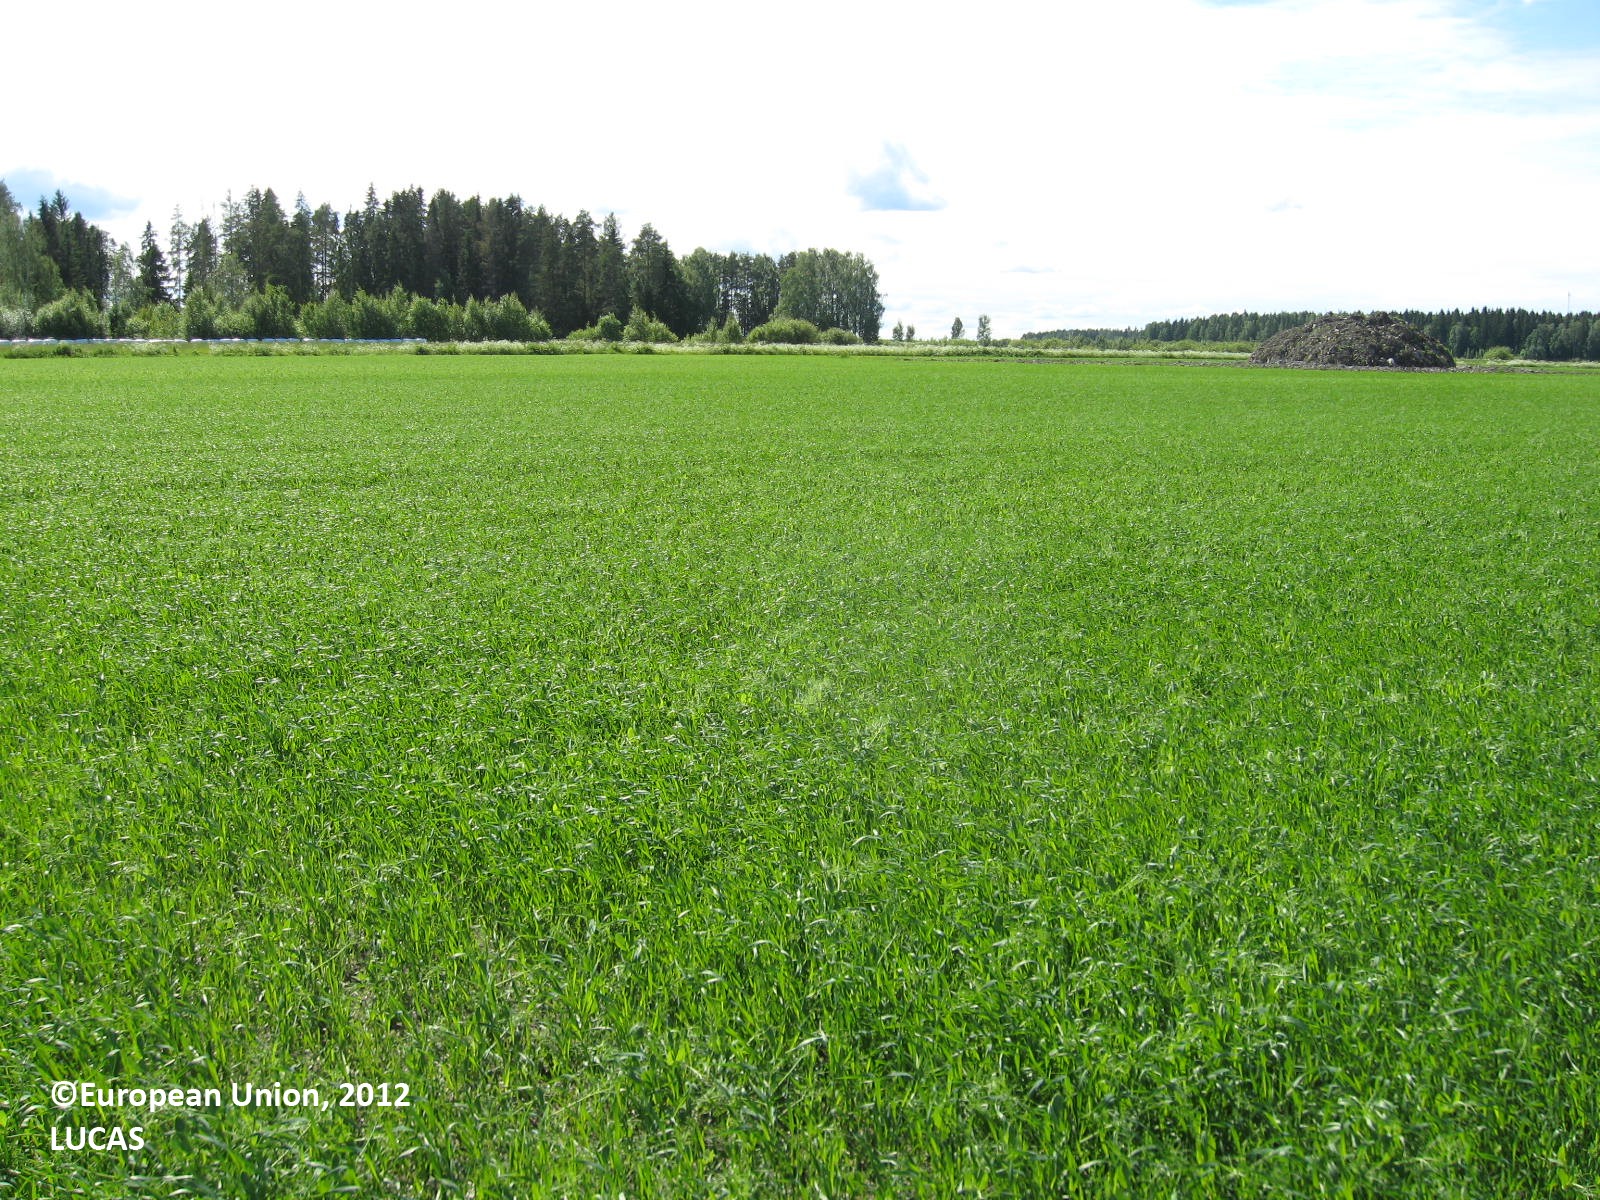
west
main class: Cropland
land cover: Temporary grasslands
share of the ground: > 75 %
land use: Agriculture (excluding fallow land and kitchen gardens)
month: June
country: FI
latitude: 62.8103
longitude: 22.6292
